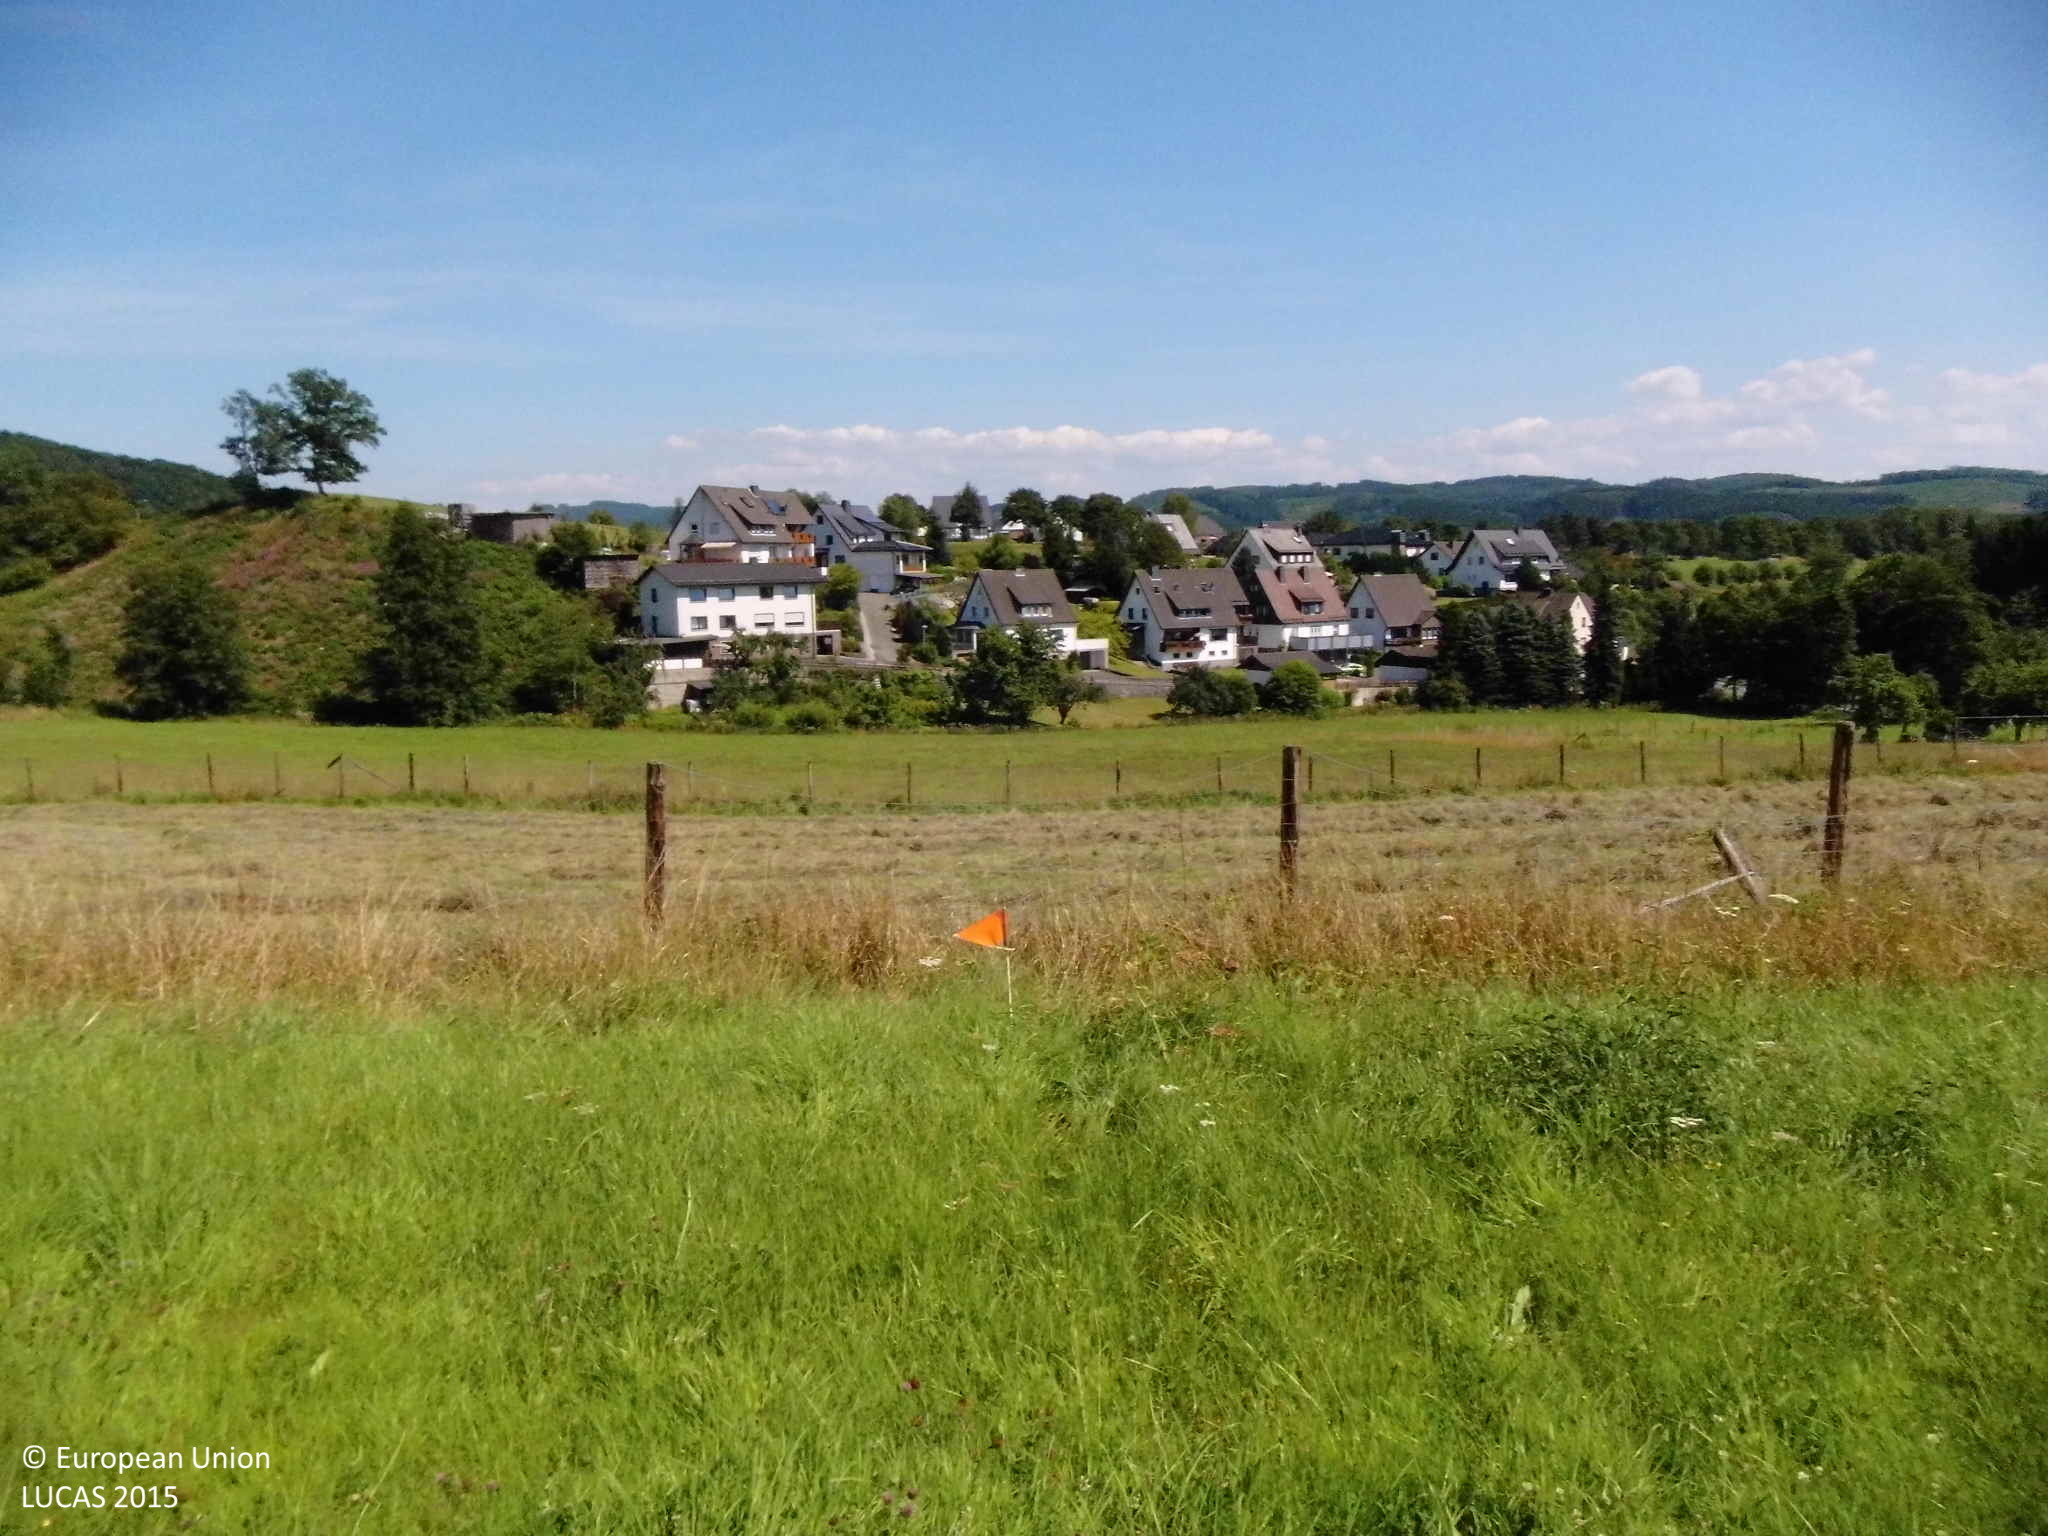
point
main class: Grassland
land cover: Grassland without tree/shrub cover
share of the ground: > 75 %
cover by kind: herbaceous plants 100 %
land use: Agriculture (excluding fallow land and kitchen gardens)
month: August
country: DE
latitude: 51.1921
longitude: 8.0114
